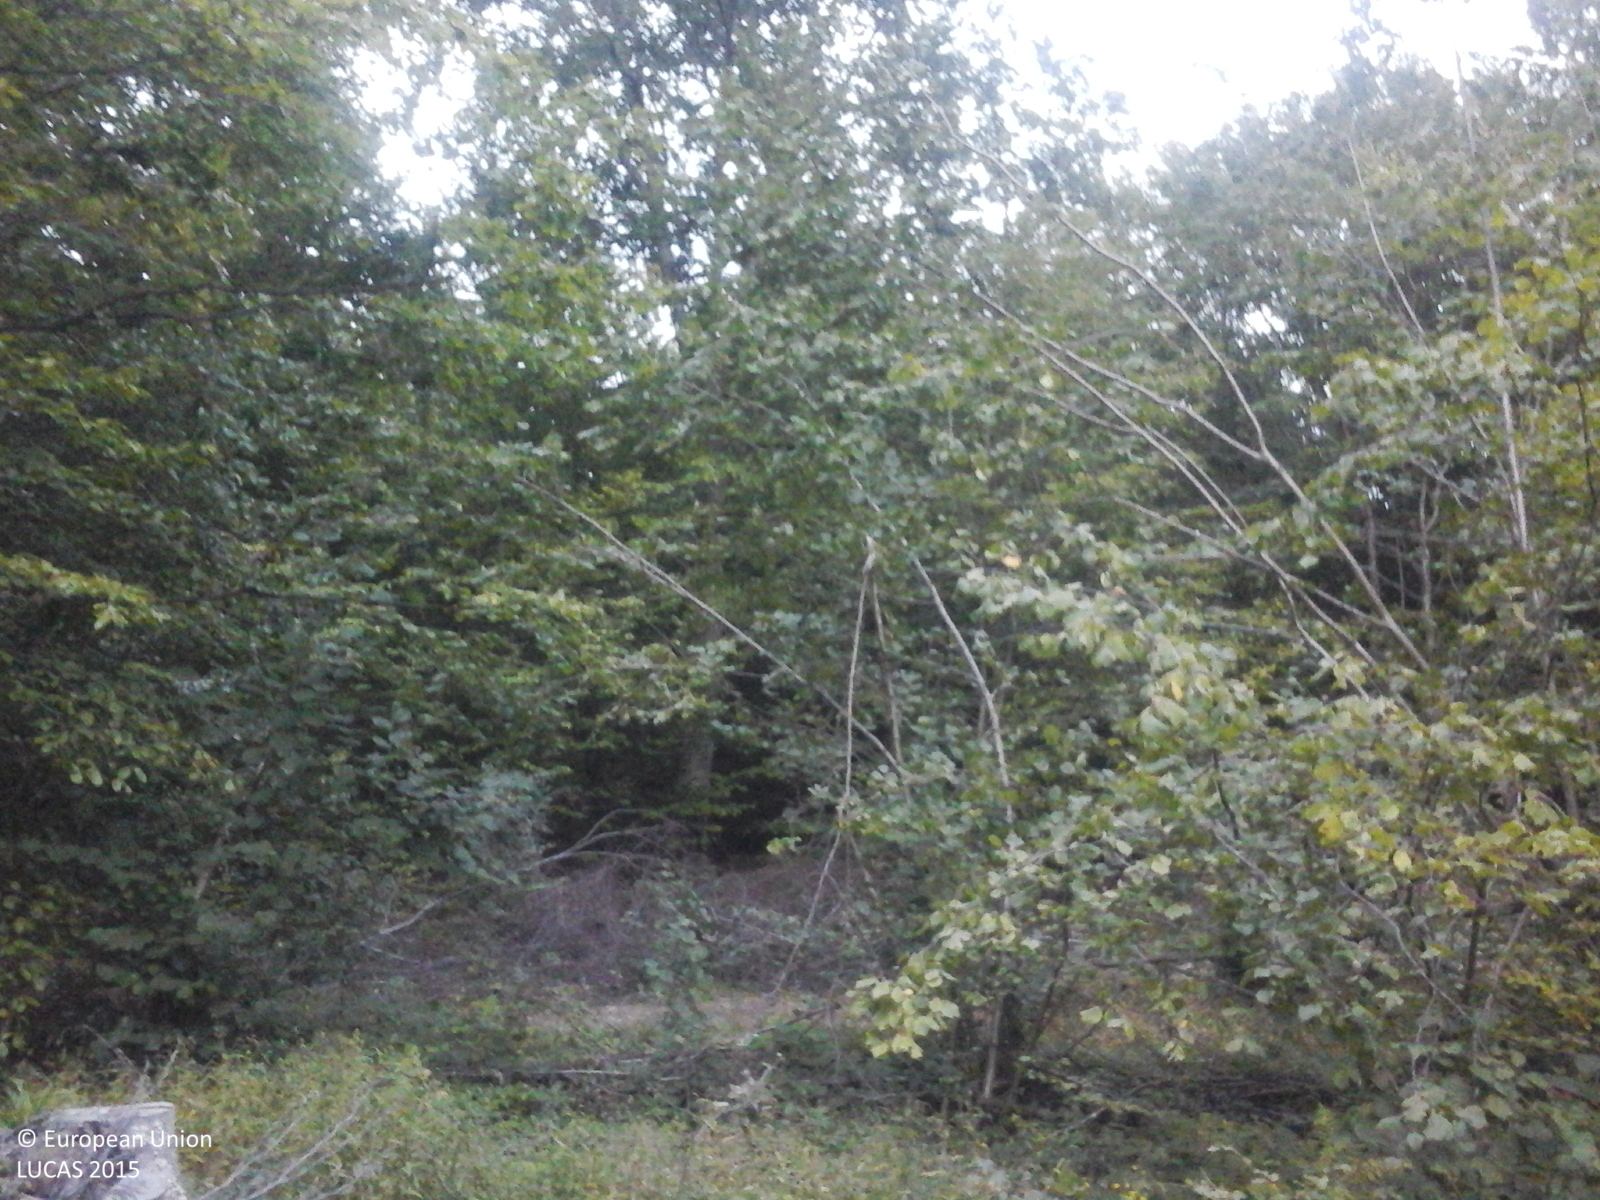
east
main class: Woodland
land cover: Broadleaved woodland
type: beech forest
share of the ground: > 75 %
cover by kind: broadleaved forest trees 100 %
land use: Forestry
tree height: > 5 m
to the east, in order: Broadleaved woodland
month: September
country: RO
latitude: 46.7115
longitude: 23.3701
